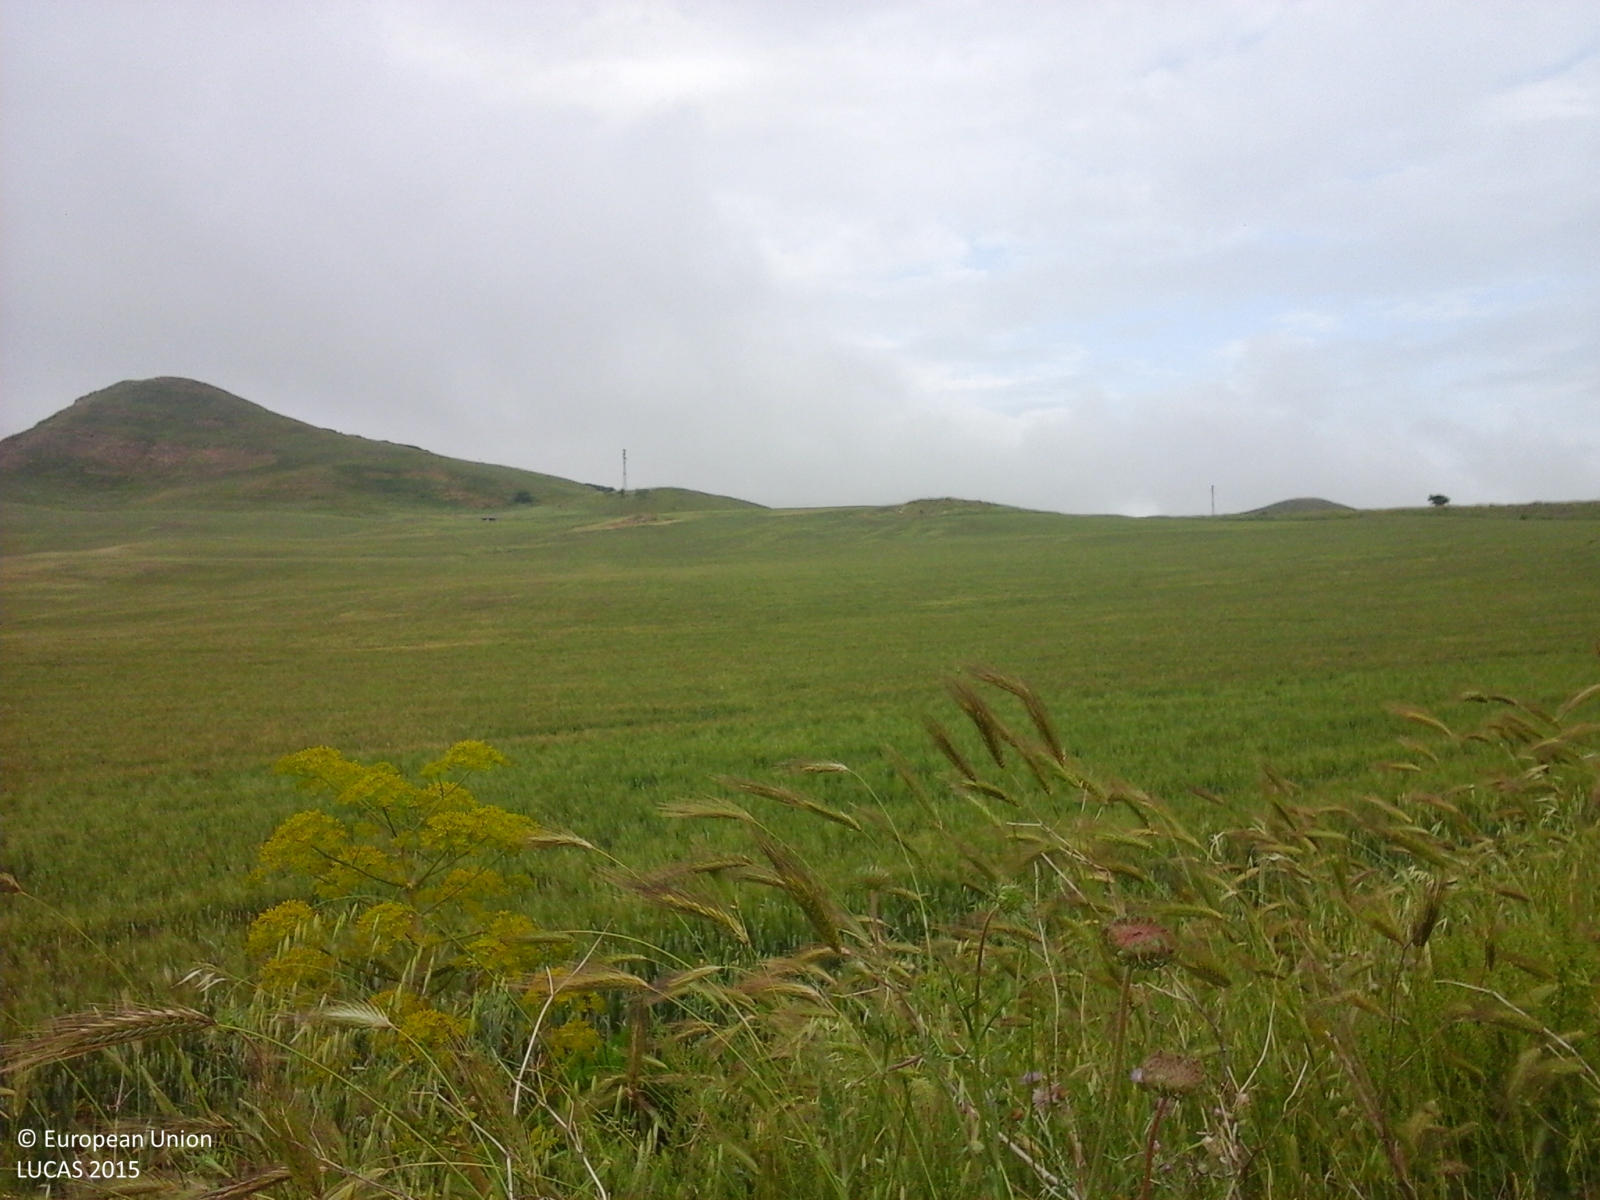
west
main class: Cropland
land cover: Durum wheat
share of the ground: > 75 %
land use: Agriculture (excluding fallow land and kitchen gardens)
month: May
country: IT
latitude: 37.7180
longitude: 13.9983
